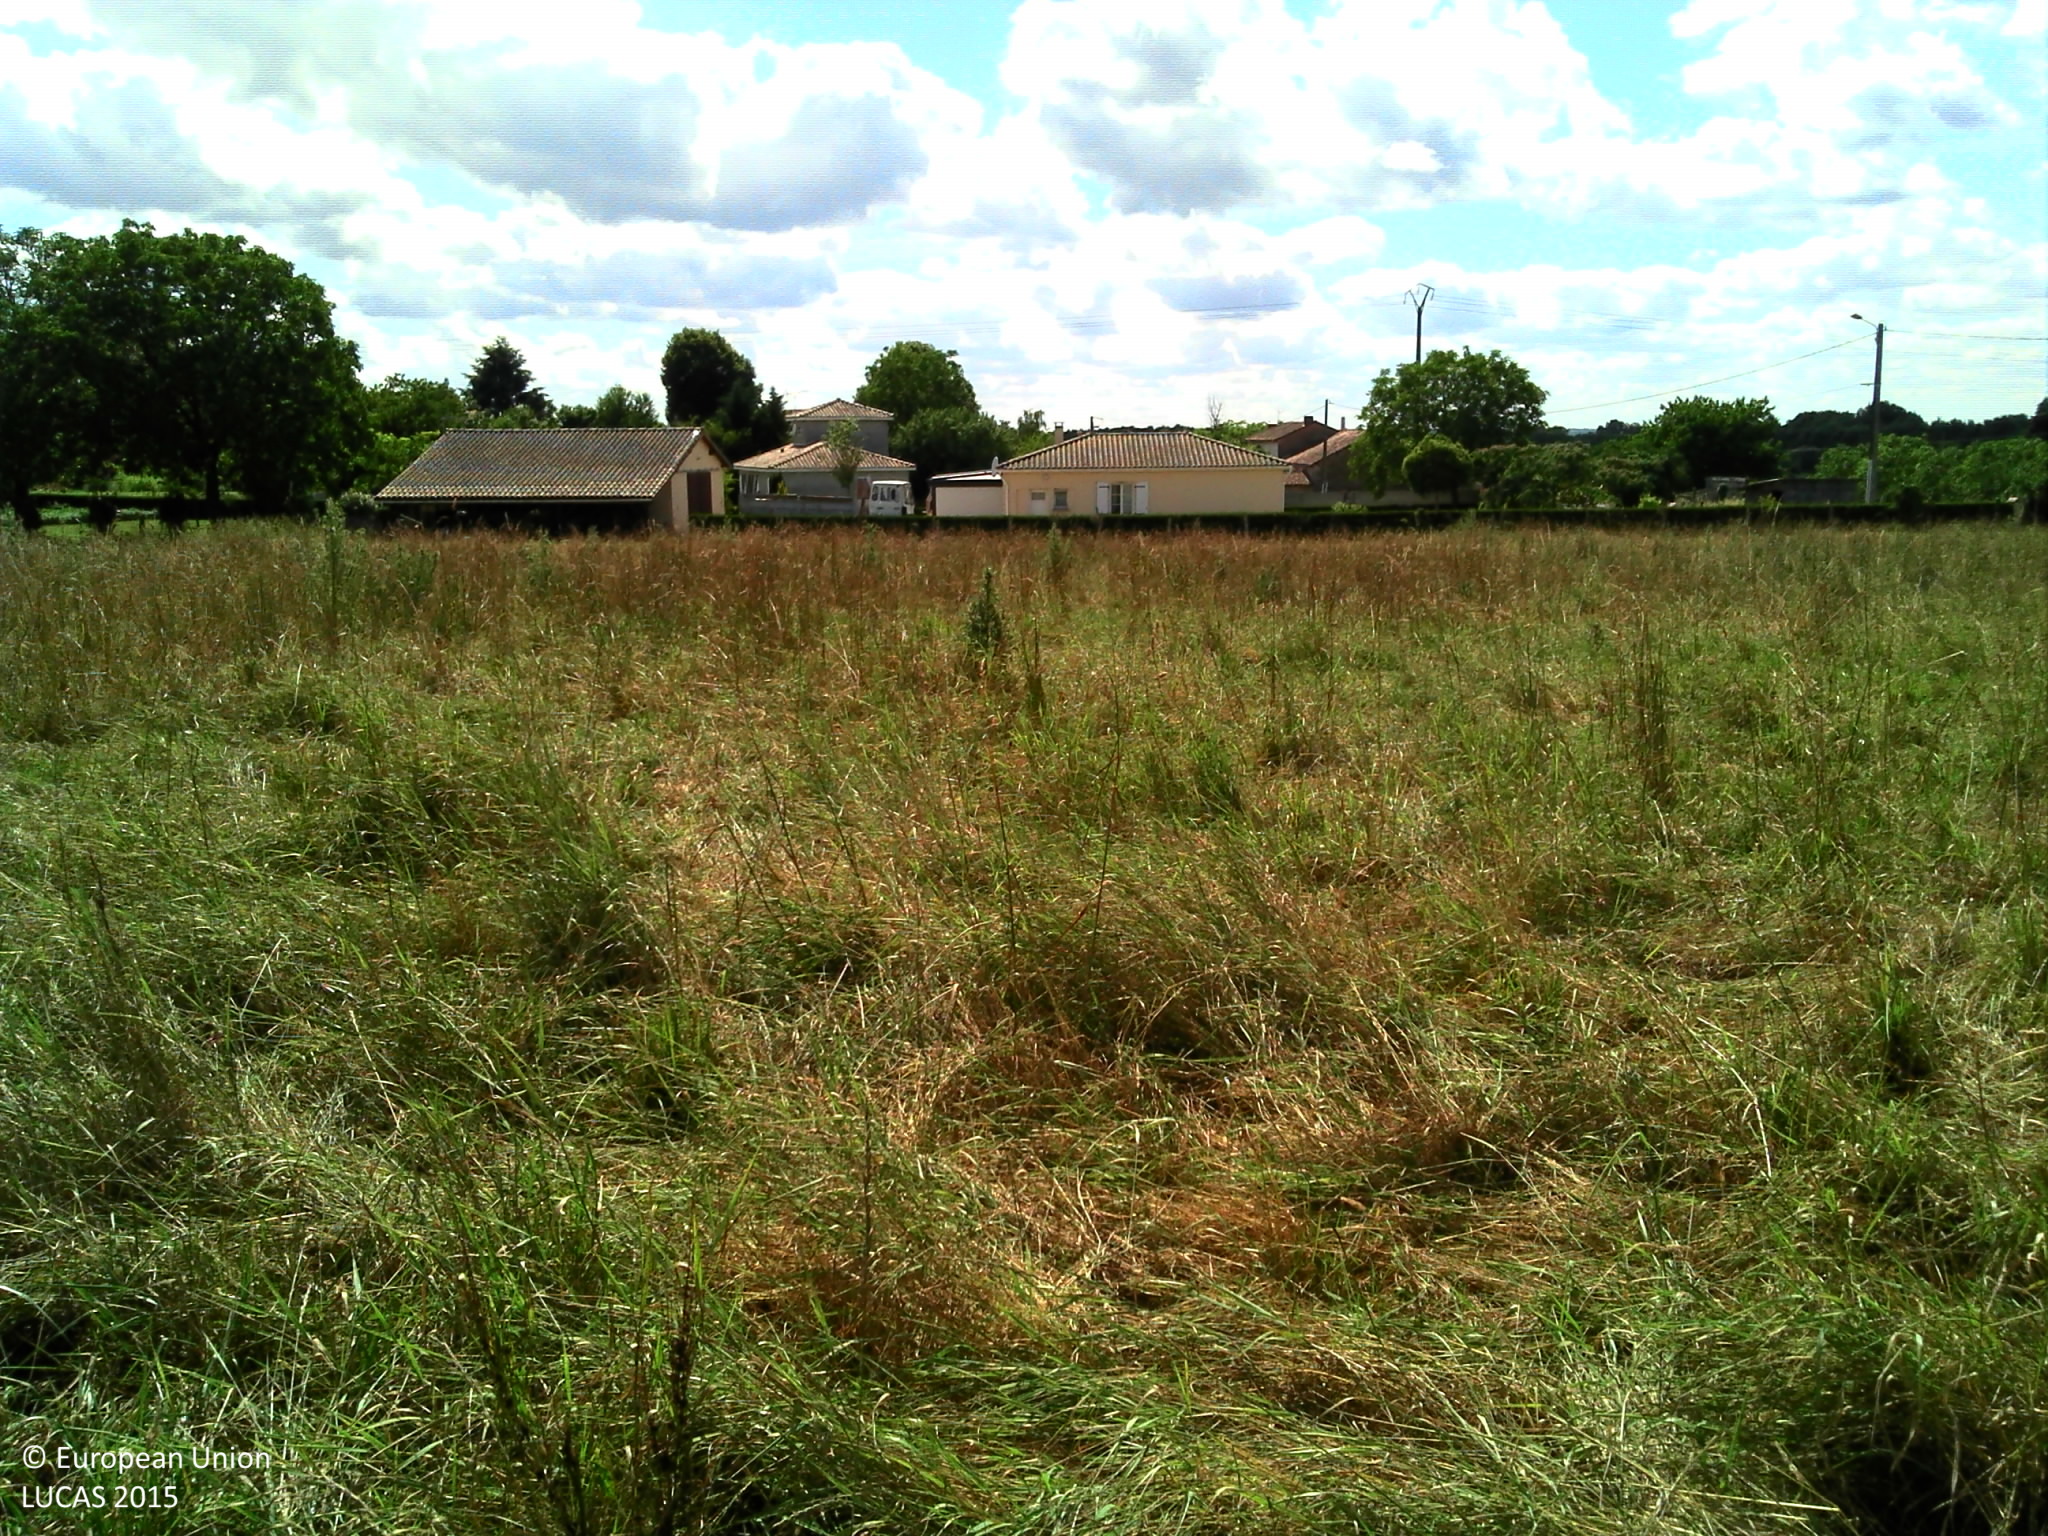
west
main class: Grassland
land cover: Grassland without tree/shrub cover
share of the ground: > 75 %
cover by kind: herbaceous plants 100 %
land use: Agriculture (excluding fallow land and kitchen gardens)
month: June
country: FR
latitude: 45.7047
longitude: 0.4423
